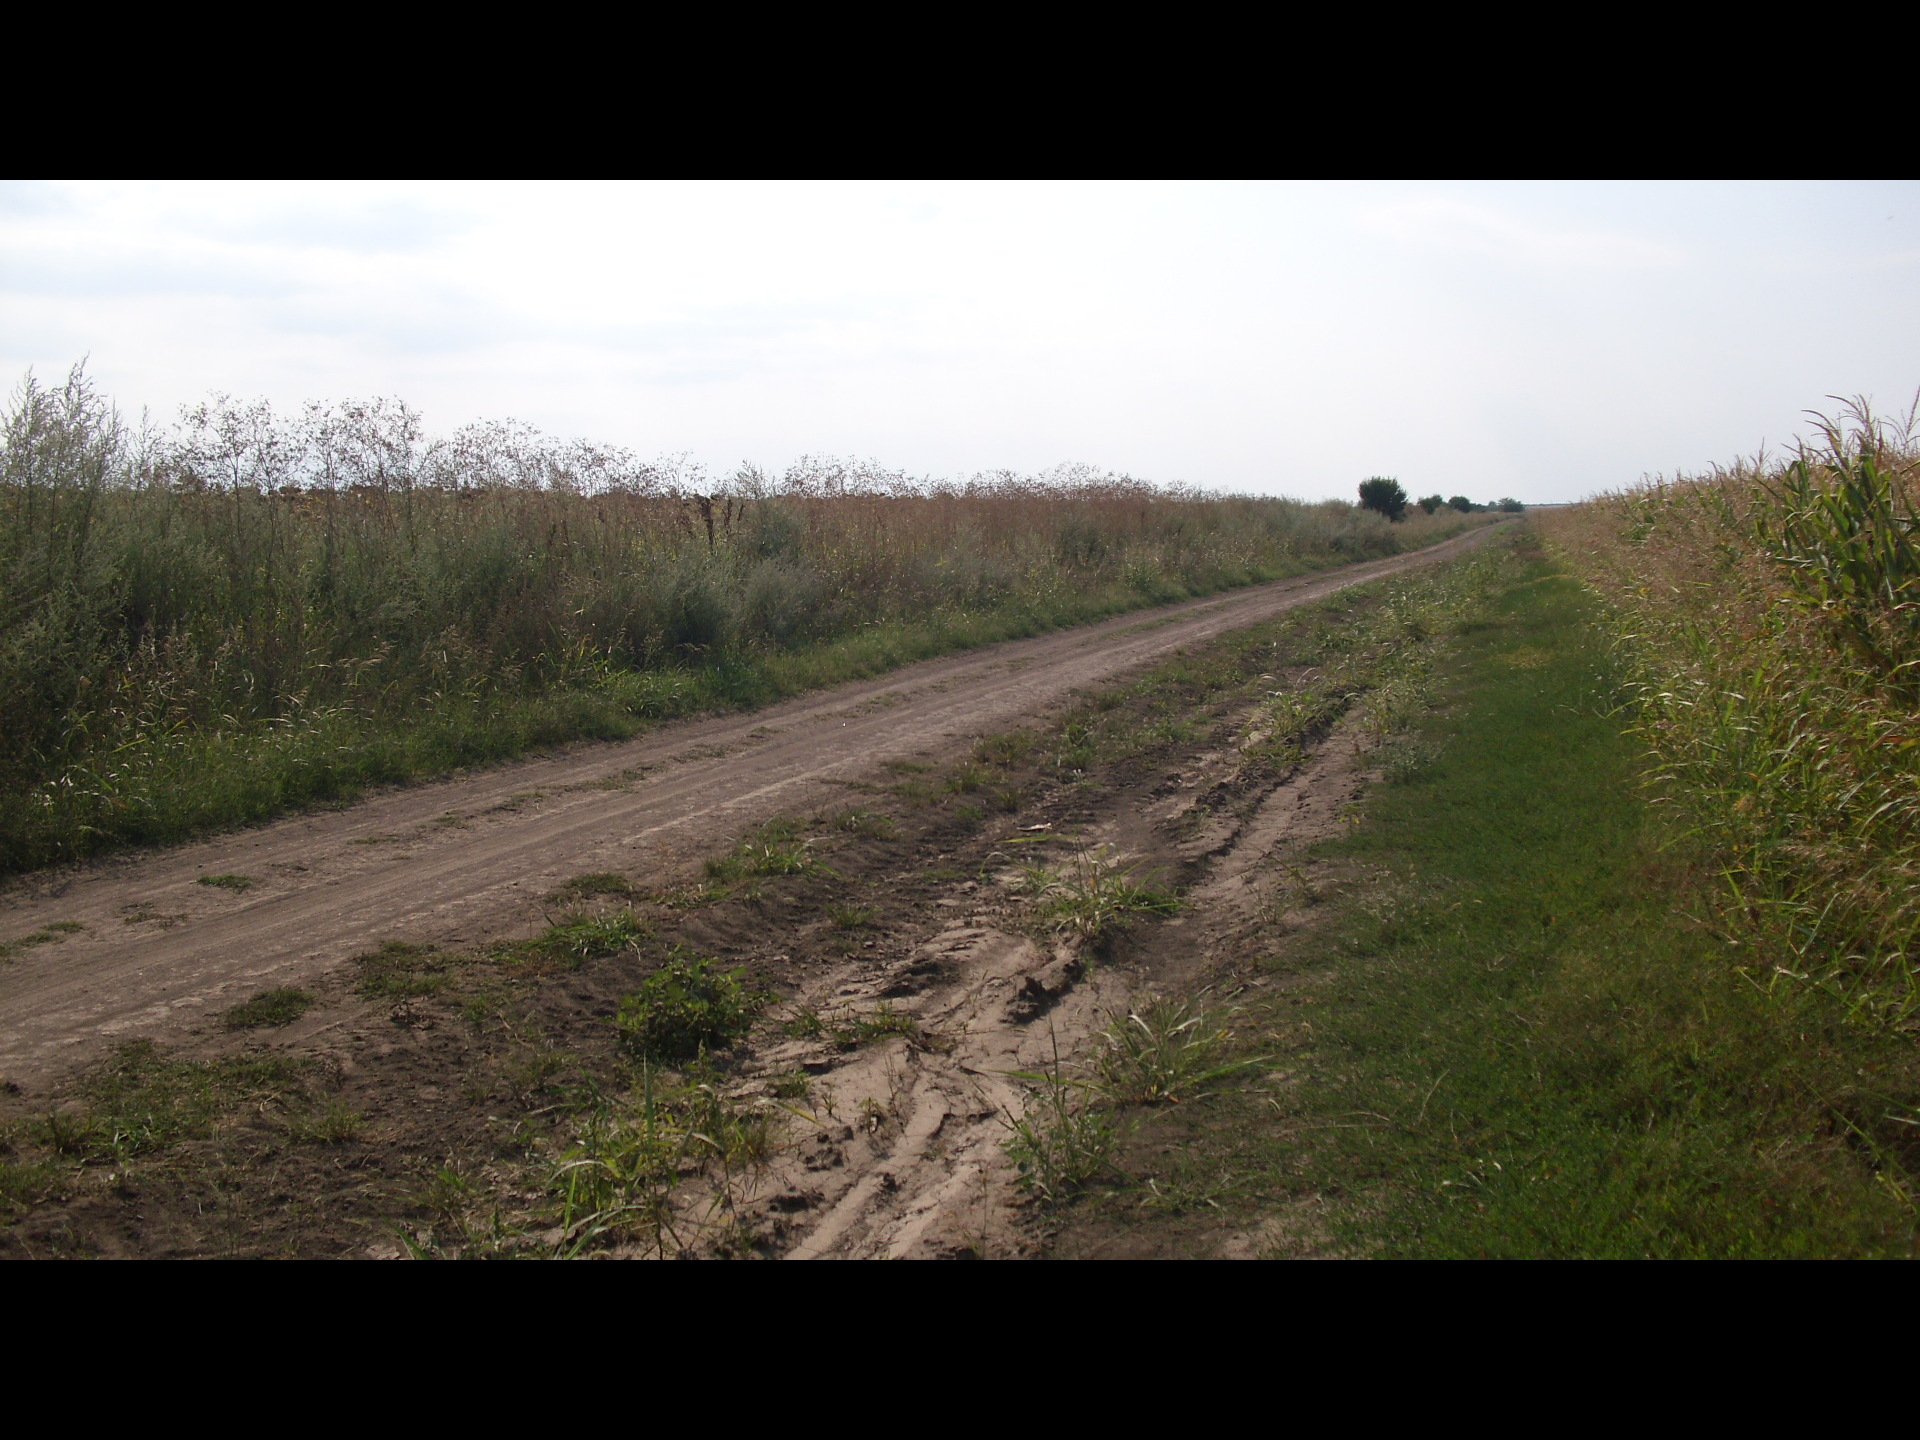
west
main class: Cropland
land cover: Maize
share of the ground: > 75 %
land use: Agriculture (excluding fallow land and kitchen gardens)
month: August
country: BG
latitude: 43.6738
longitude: 23.7053
